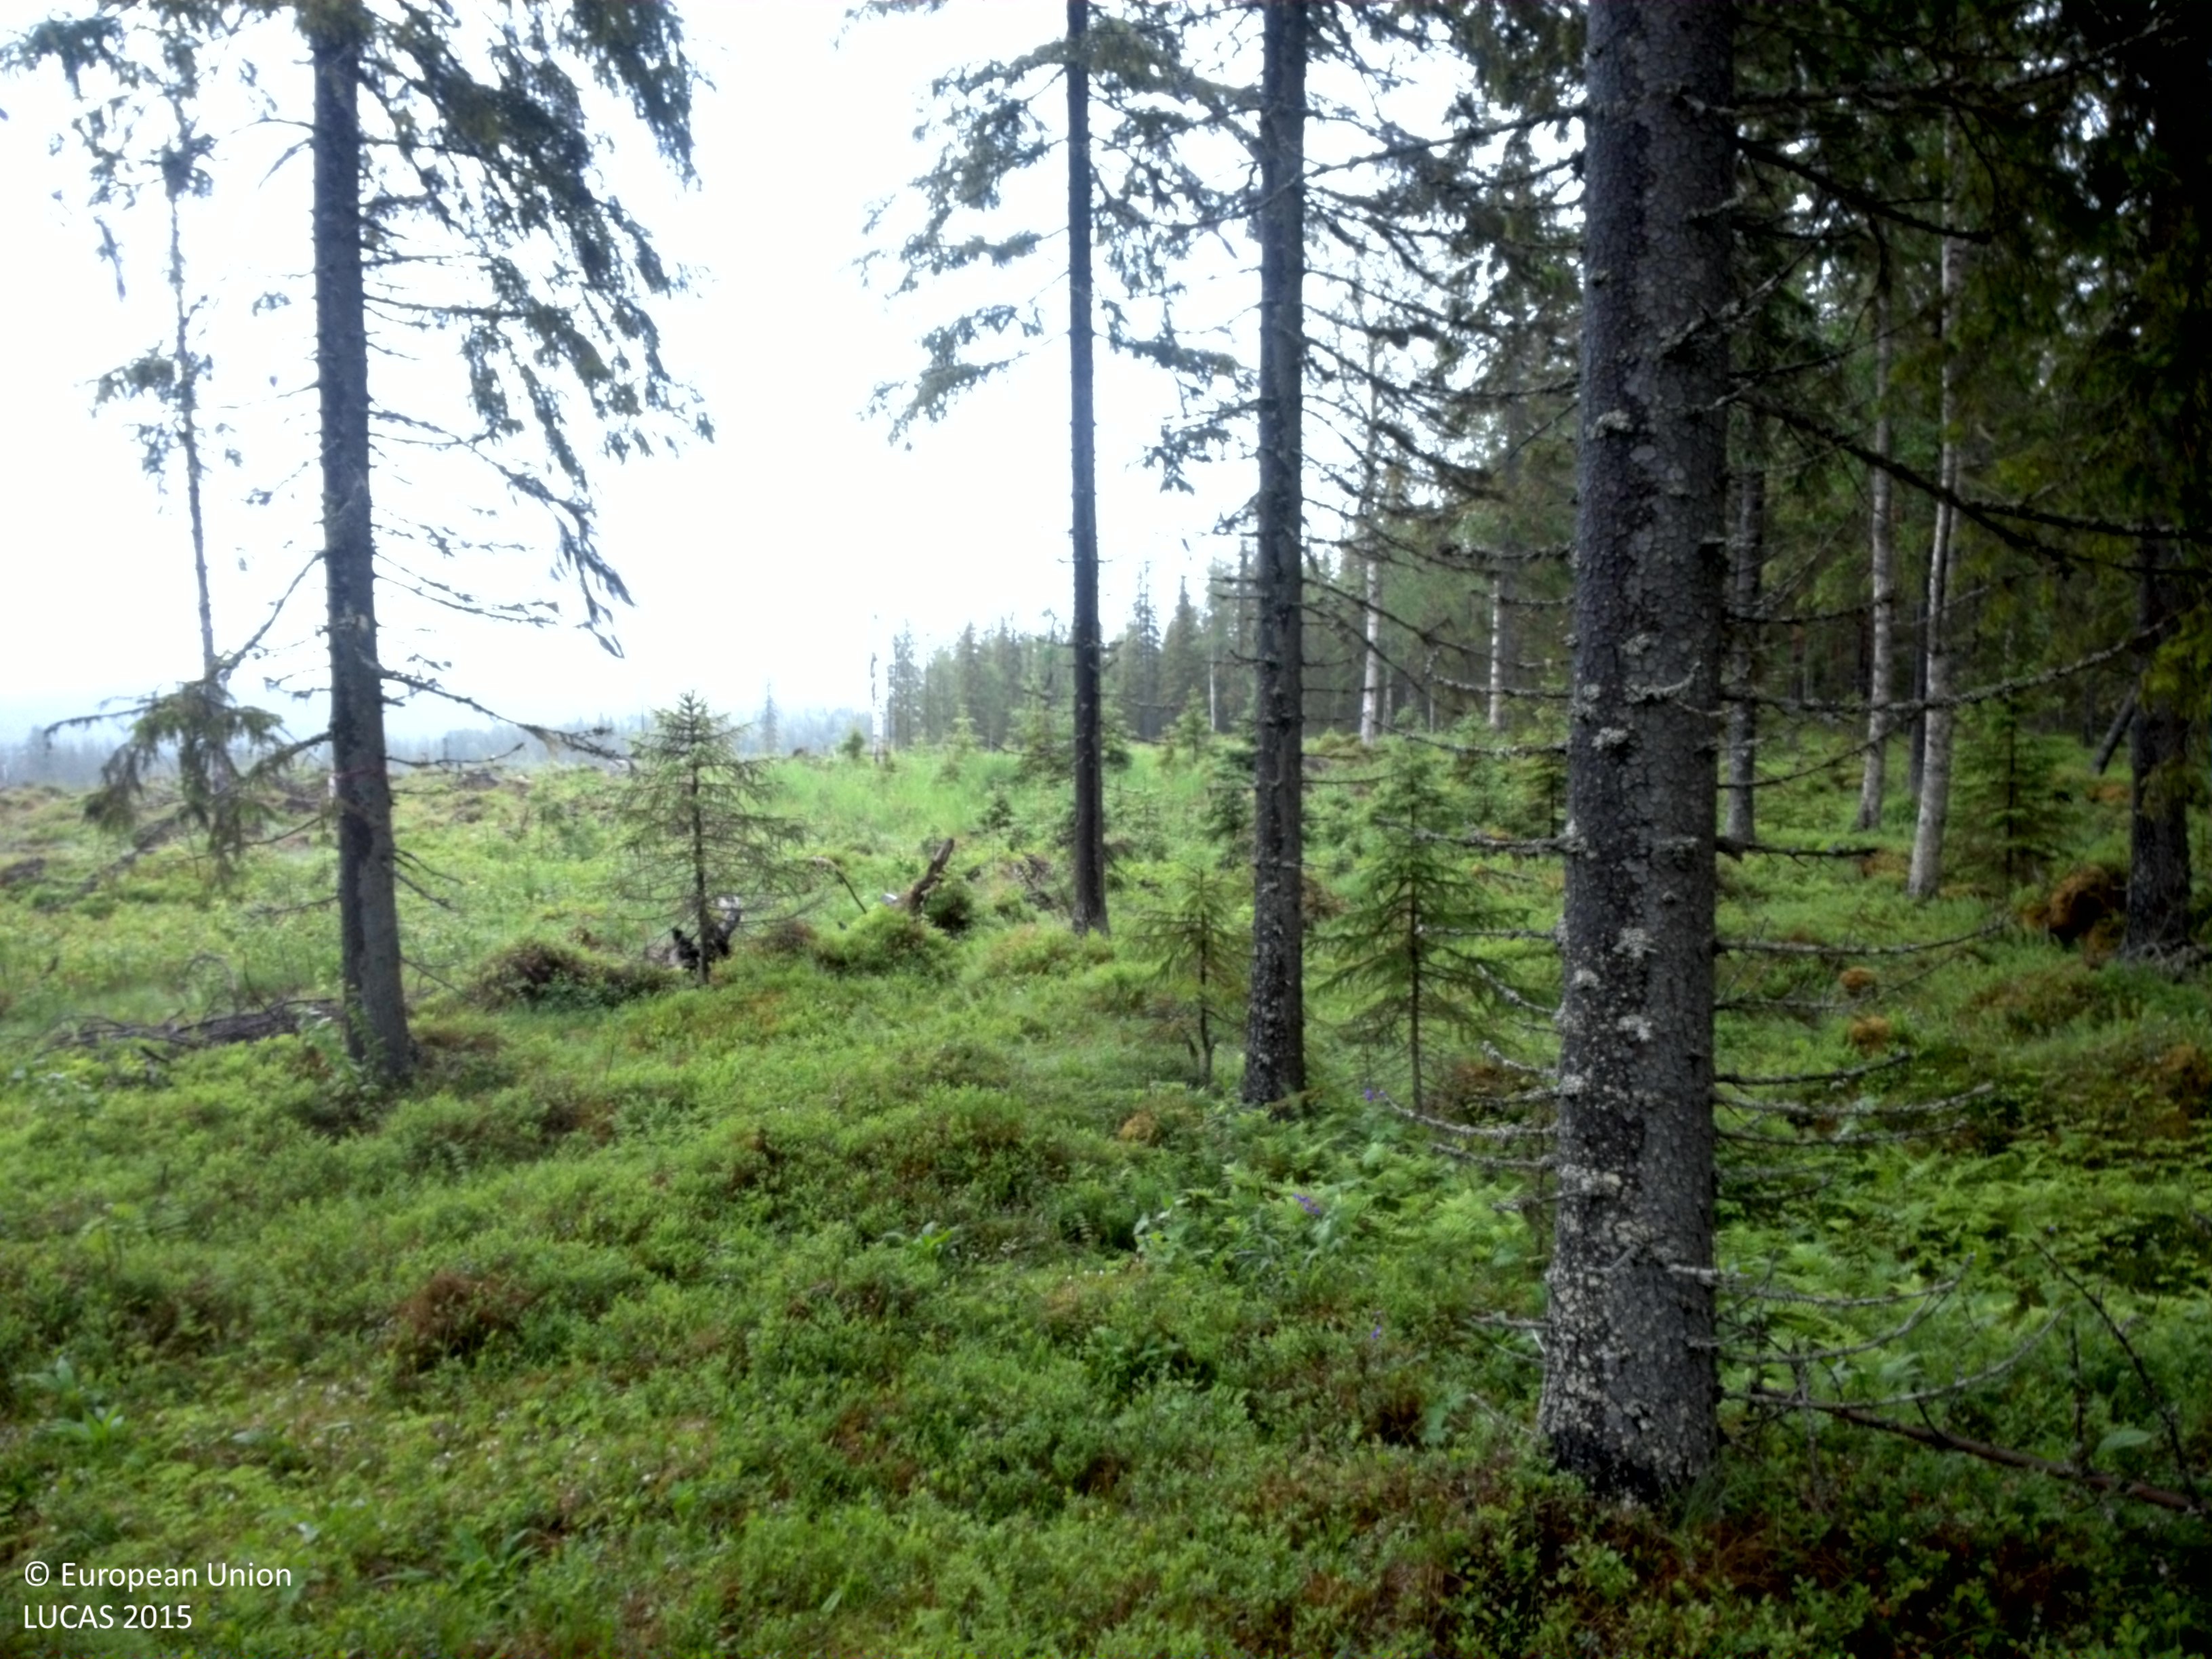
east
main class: Woodland
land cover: Spruce dominated mixed woodland
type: boreal forest
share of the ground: 50 - 75 %
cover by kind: coniferous forest trees 45 %, shrubs 35 %, broadleaved forest trees 15 %, herbaceous plants 5 %
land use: Forestry
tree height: > 5 m
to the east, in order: Spruce dominated mixed woodland; Ditches and canals; Shrubland with sparse tree cover; Ditches and canals; Shrubland with sparse tree cover; Spruce dominated mixed woodland; Spruce dominated coniferous woodland
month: July
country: SE
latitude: 64.5733
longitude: 18.0872
